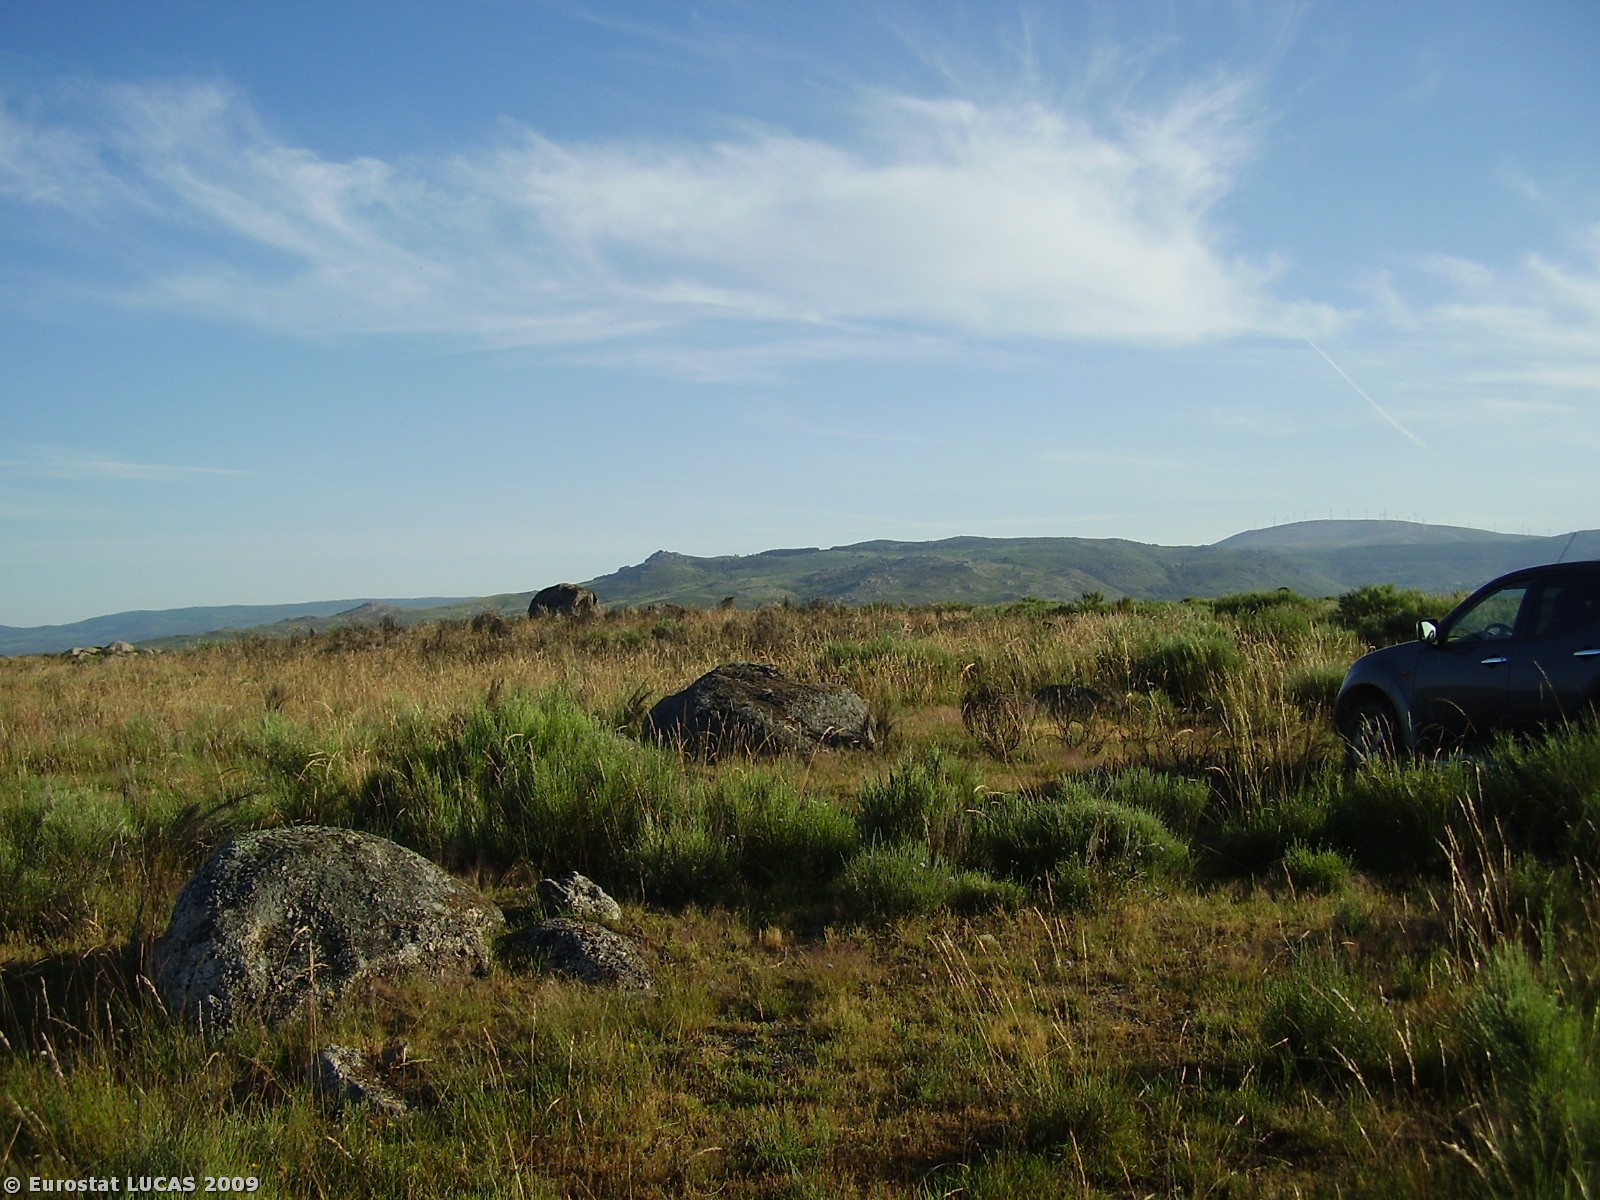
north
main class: Grassland
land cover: Spontaneously vegetated surfaces
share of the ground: > 75 %
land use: Nature reserves
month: June
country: PT
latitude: 41.9595
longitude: -7.0005
